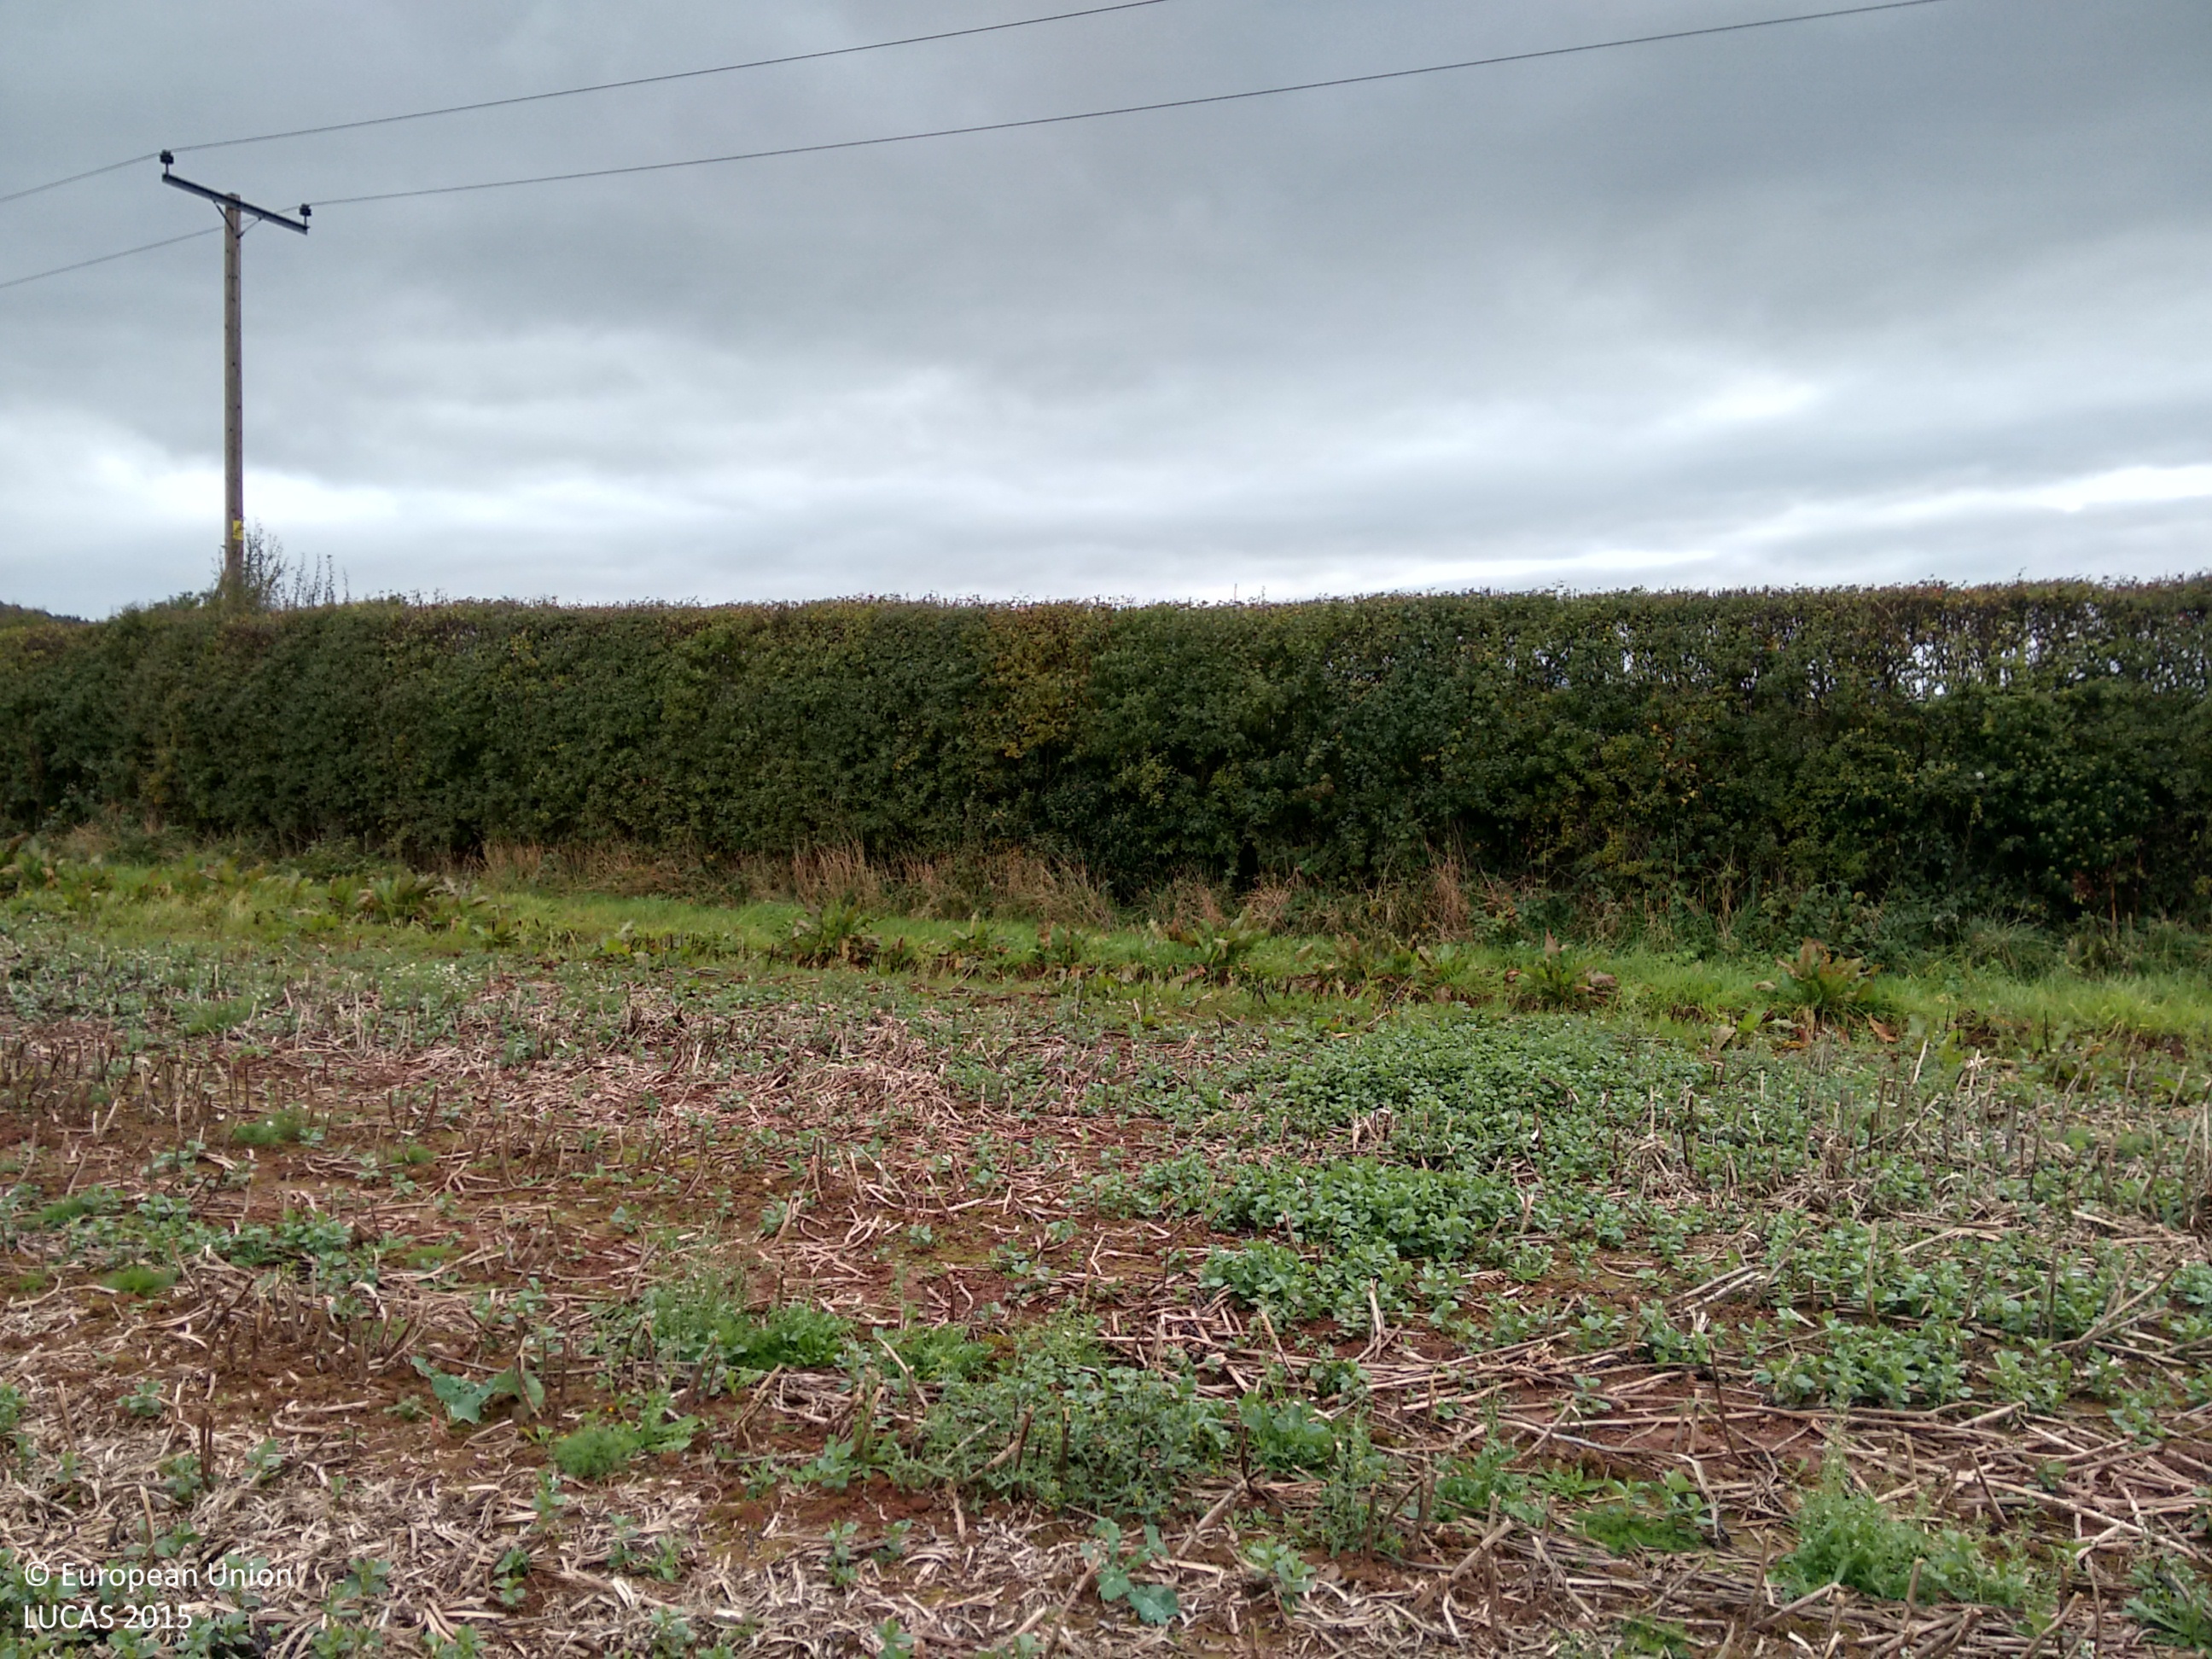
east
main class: Cropland
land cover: Dry pulses
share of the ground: > 75 %
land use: Agriculture (excluding fallow land and kitchen gardens)
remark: Harvested field
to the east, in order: Dry pulses; Grass margins; Managed hedges; Electric lines; Grass margins; Other bare soil; Grass margins; Fences; Managed hedges; Electric lines; Grass margins; Paved roads, cycling and walking lanes; Grass margins; Managed hedges; Fences; Grassland without tree/shrub cover
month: October
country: GB
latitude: 52.1542
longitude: -2.8023
